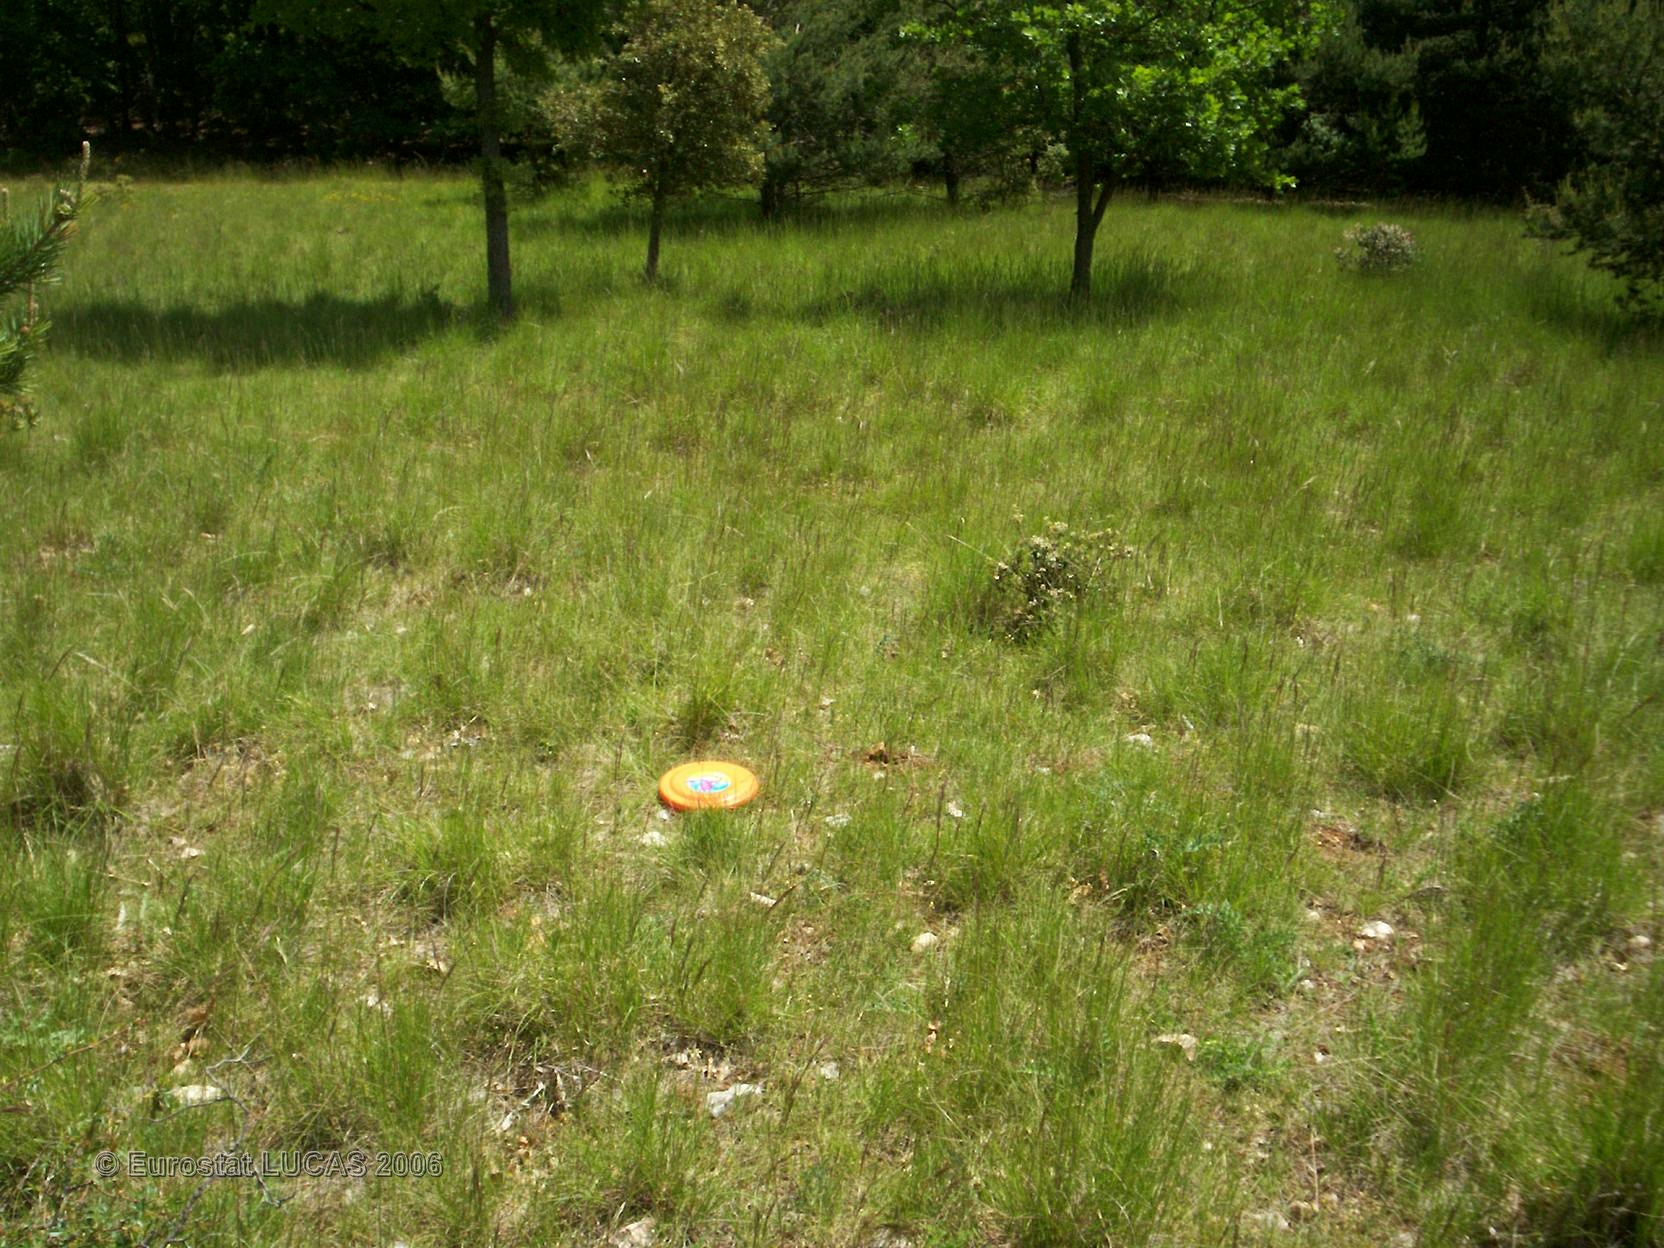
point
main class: Grassland
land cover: Grassland with sparse tree/shrub cover
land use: Agriculture (excluding fallow land and kitchen gardens)
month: May
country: FR
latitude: 44.0095
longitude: 5.3061
